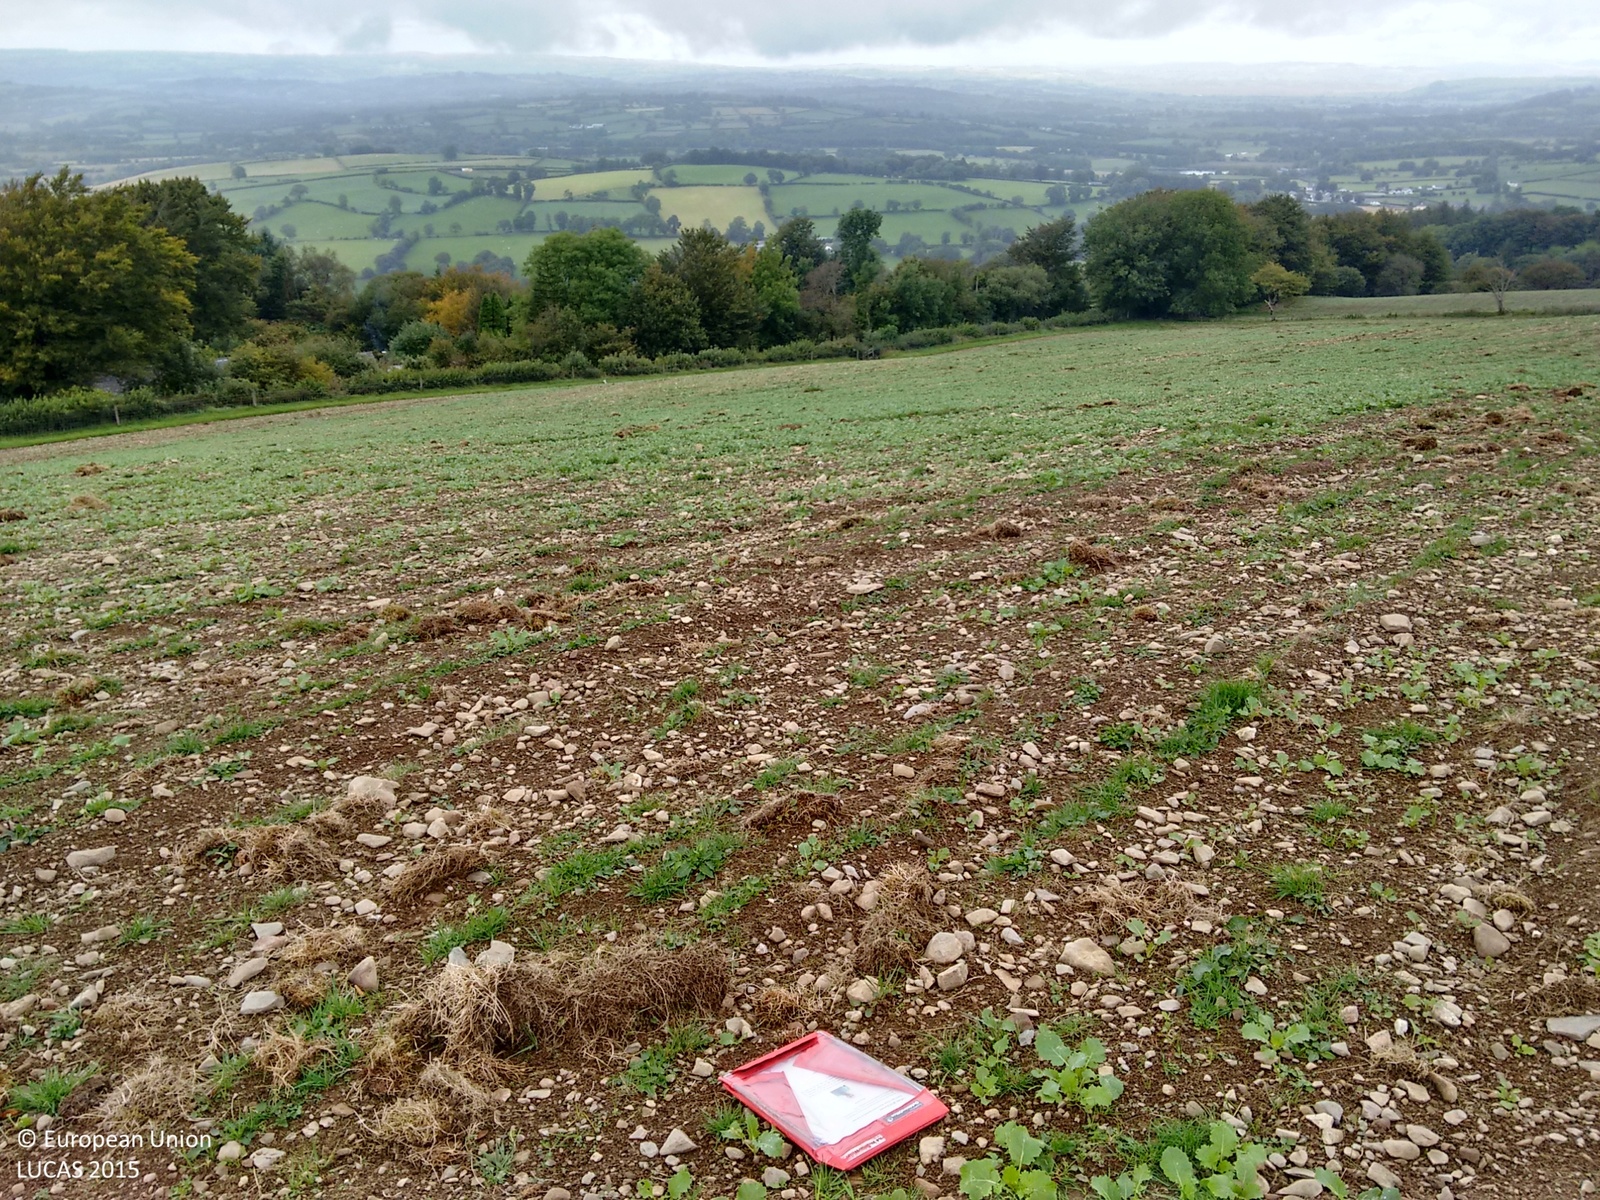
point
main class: Cropland
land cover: Other root crops
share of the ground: 25 - 50 %
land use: Agriculture (excluding fallow land and kitchen gardens)
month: September
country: GB
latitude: 52.1669
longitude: -3.9687
